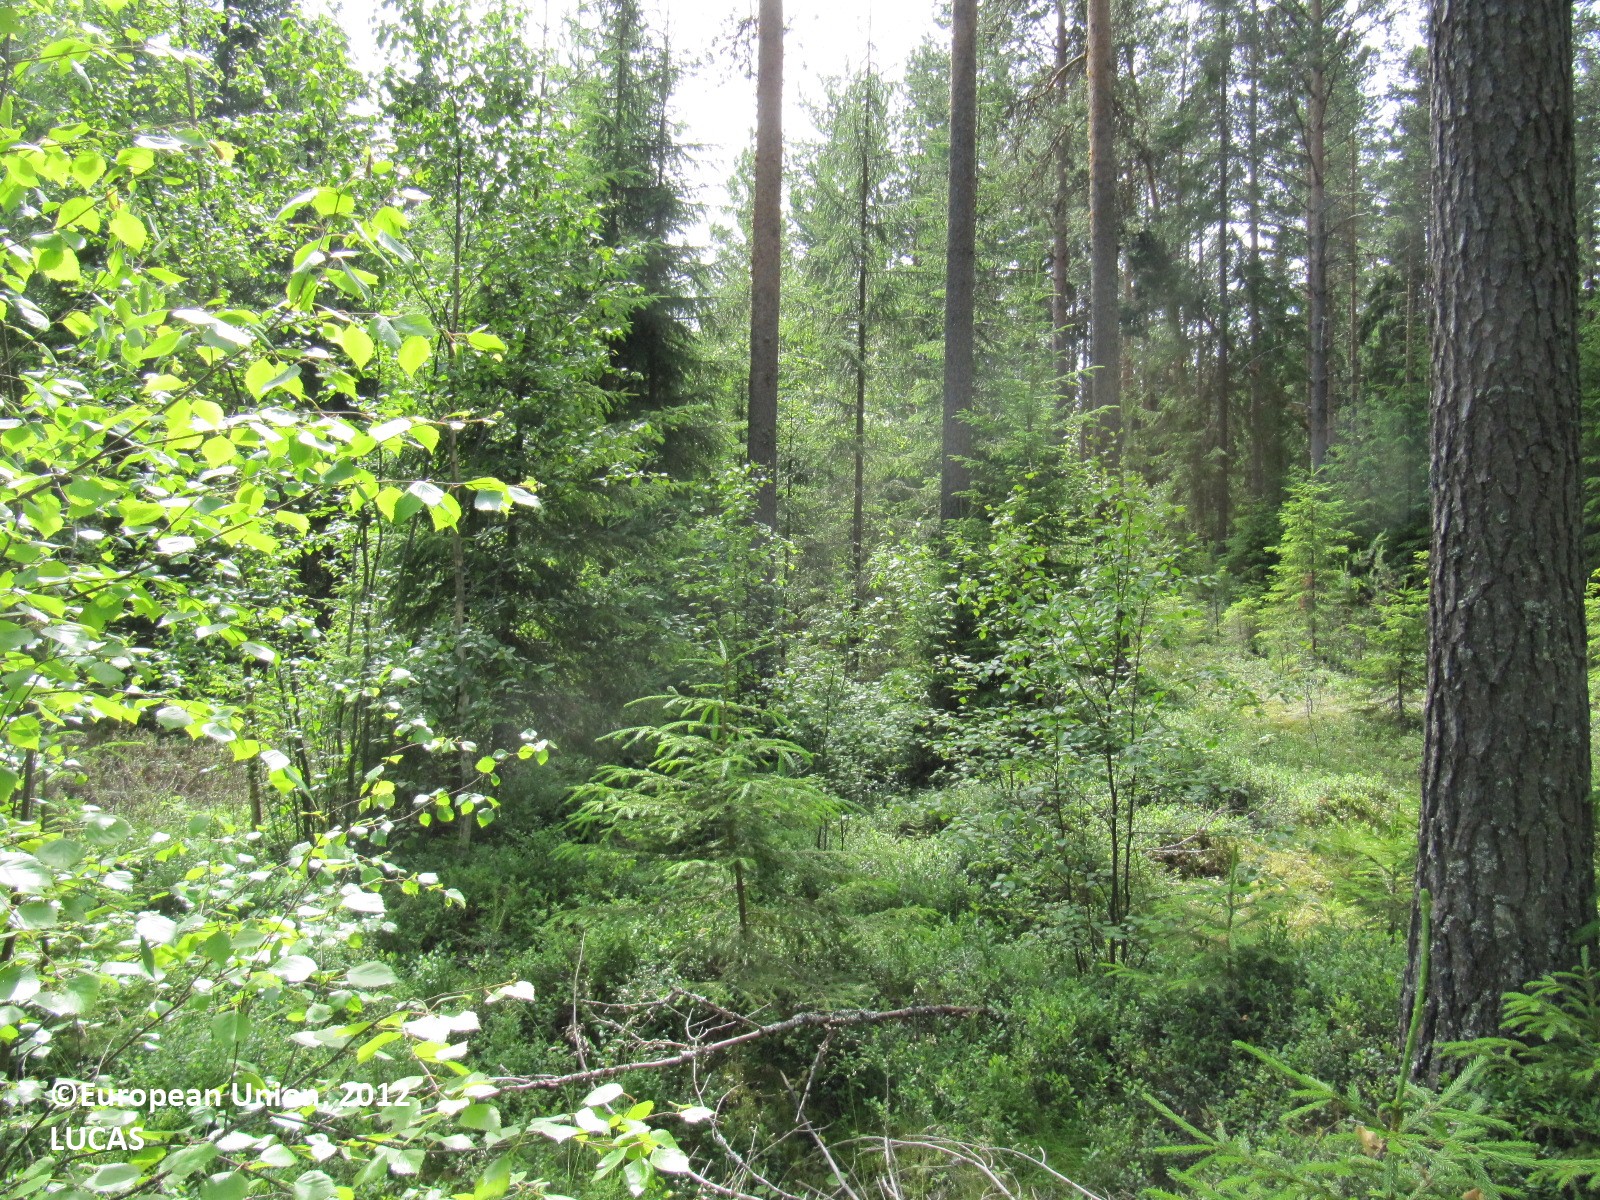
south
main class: Woodland
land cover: Other coniferous woodland
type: boreal forest
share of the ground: > 75 %
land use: Forestry
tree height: > 5 m
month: July
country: FI
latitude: 60.9864
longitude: 23.3702
